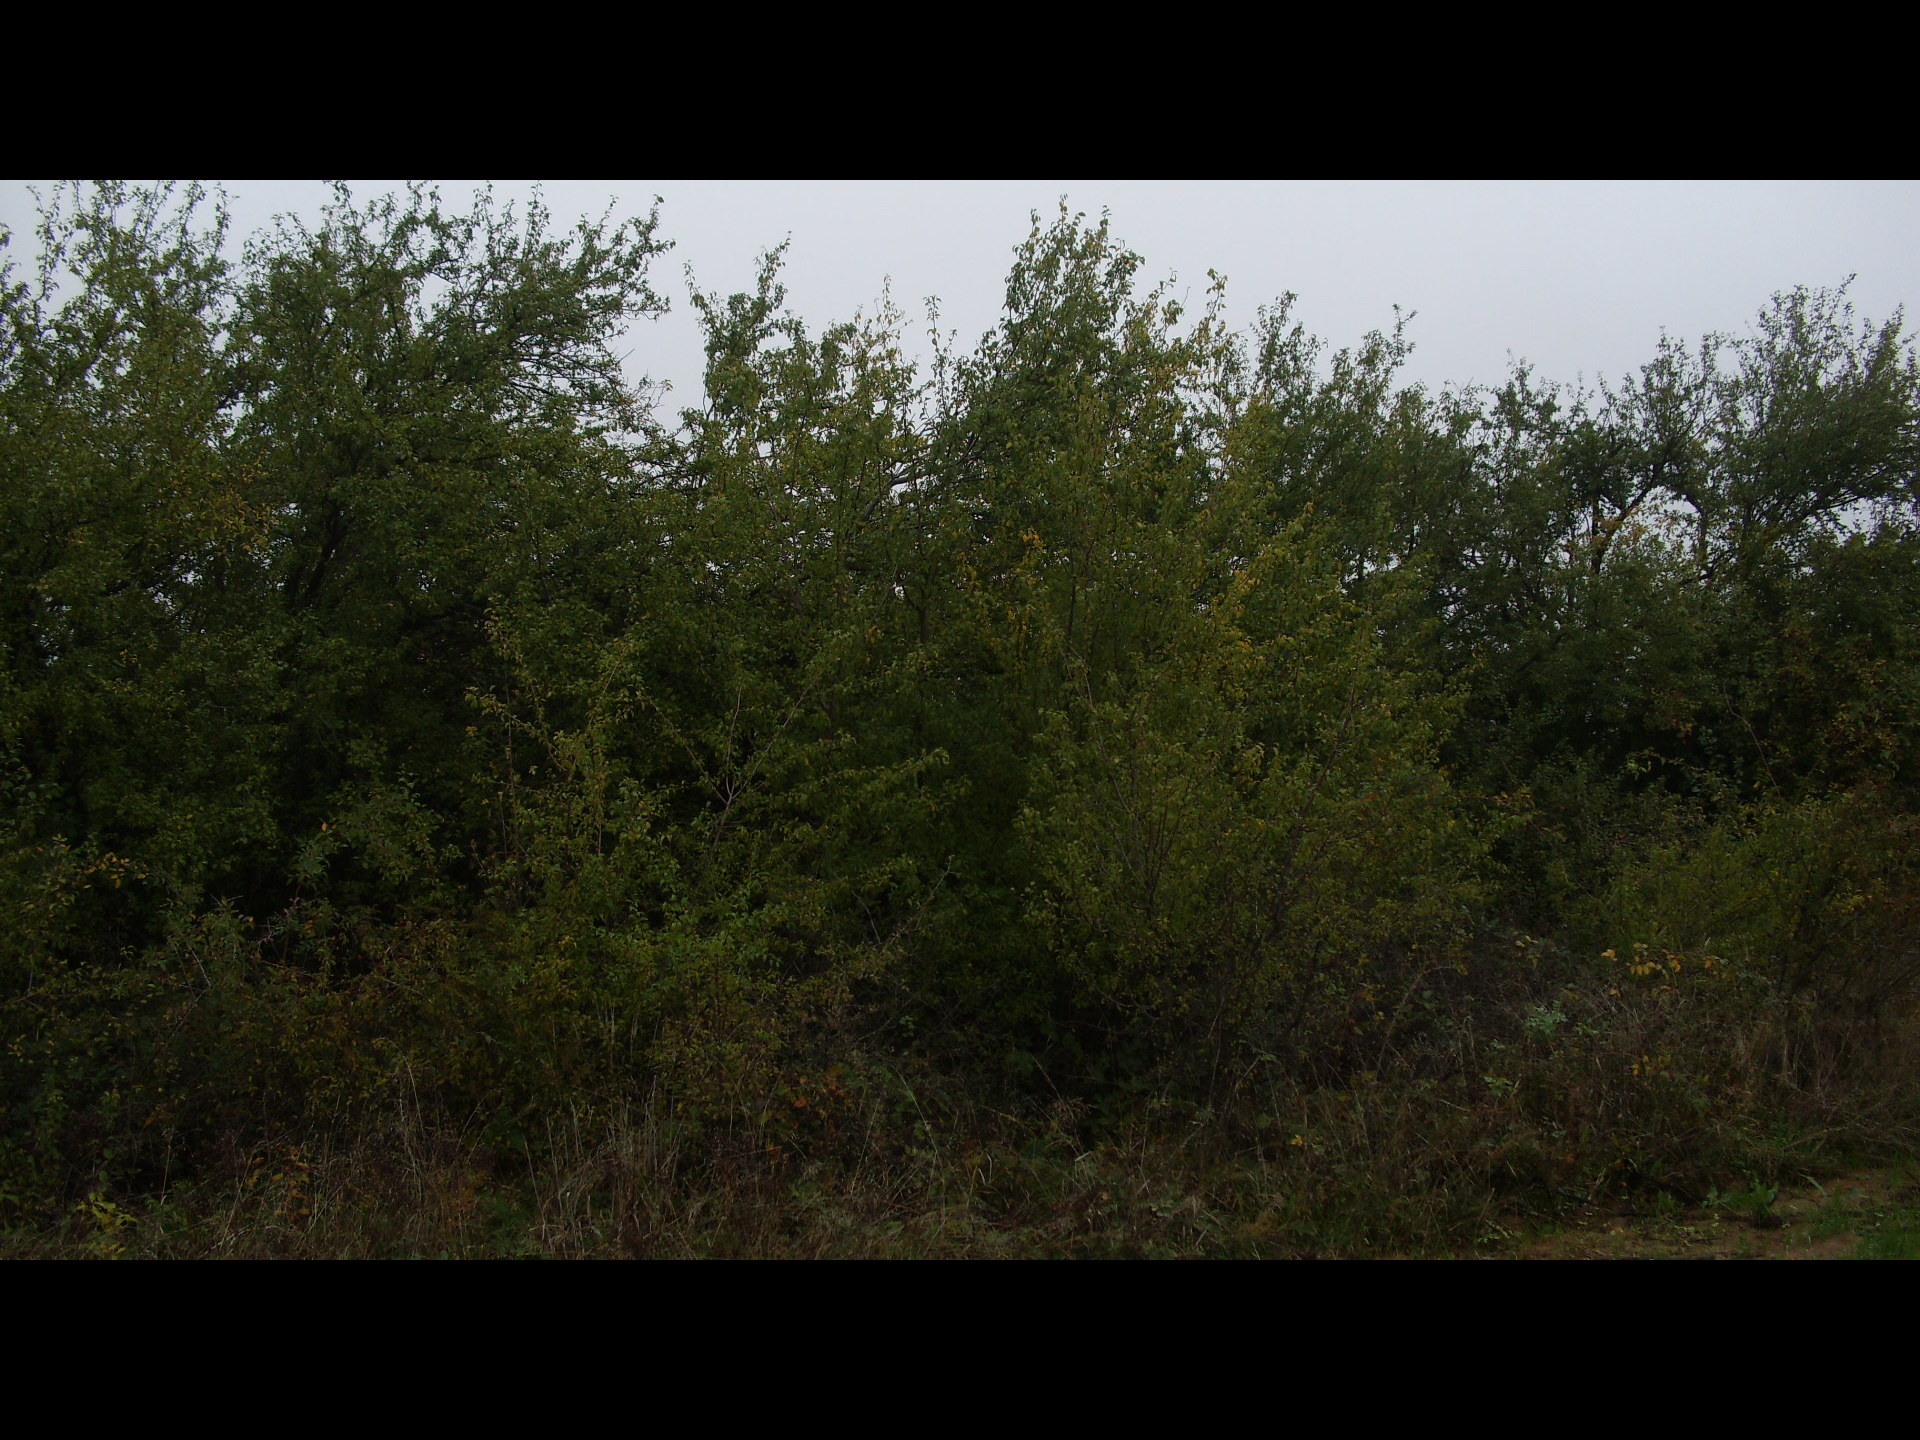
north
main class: Cropland
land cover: Pear fruit
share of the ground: 50 - 75 %
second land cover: Spontaneously vegetated surfaces
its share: > 75 %
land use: Abandoned areas
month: October
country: BG
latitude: 43.5484
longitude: 22.8460
